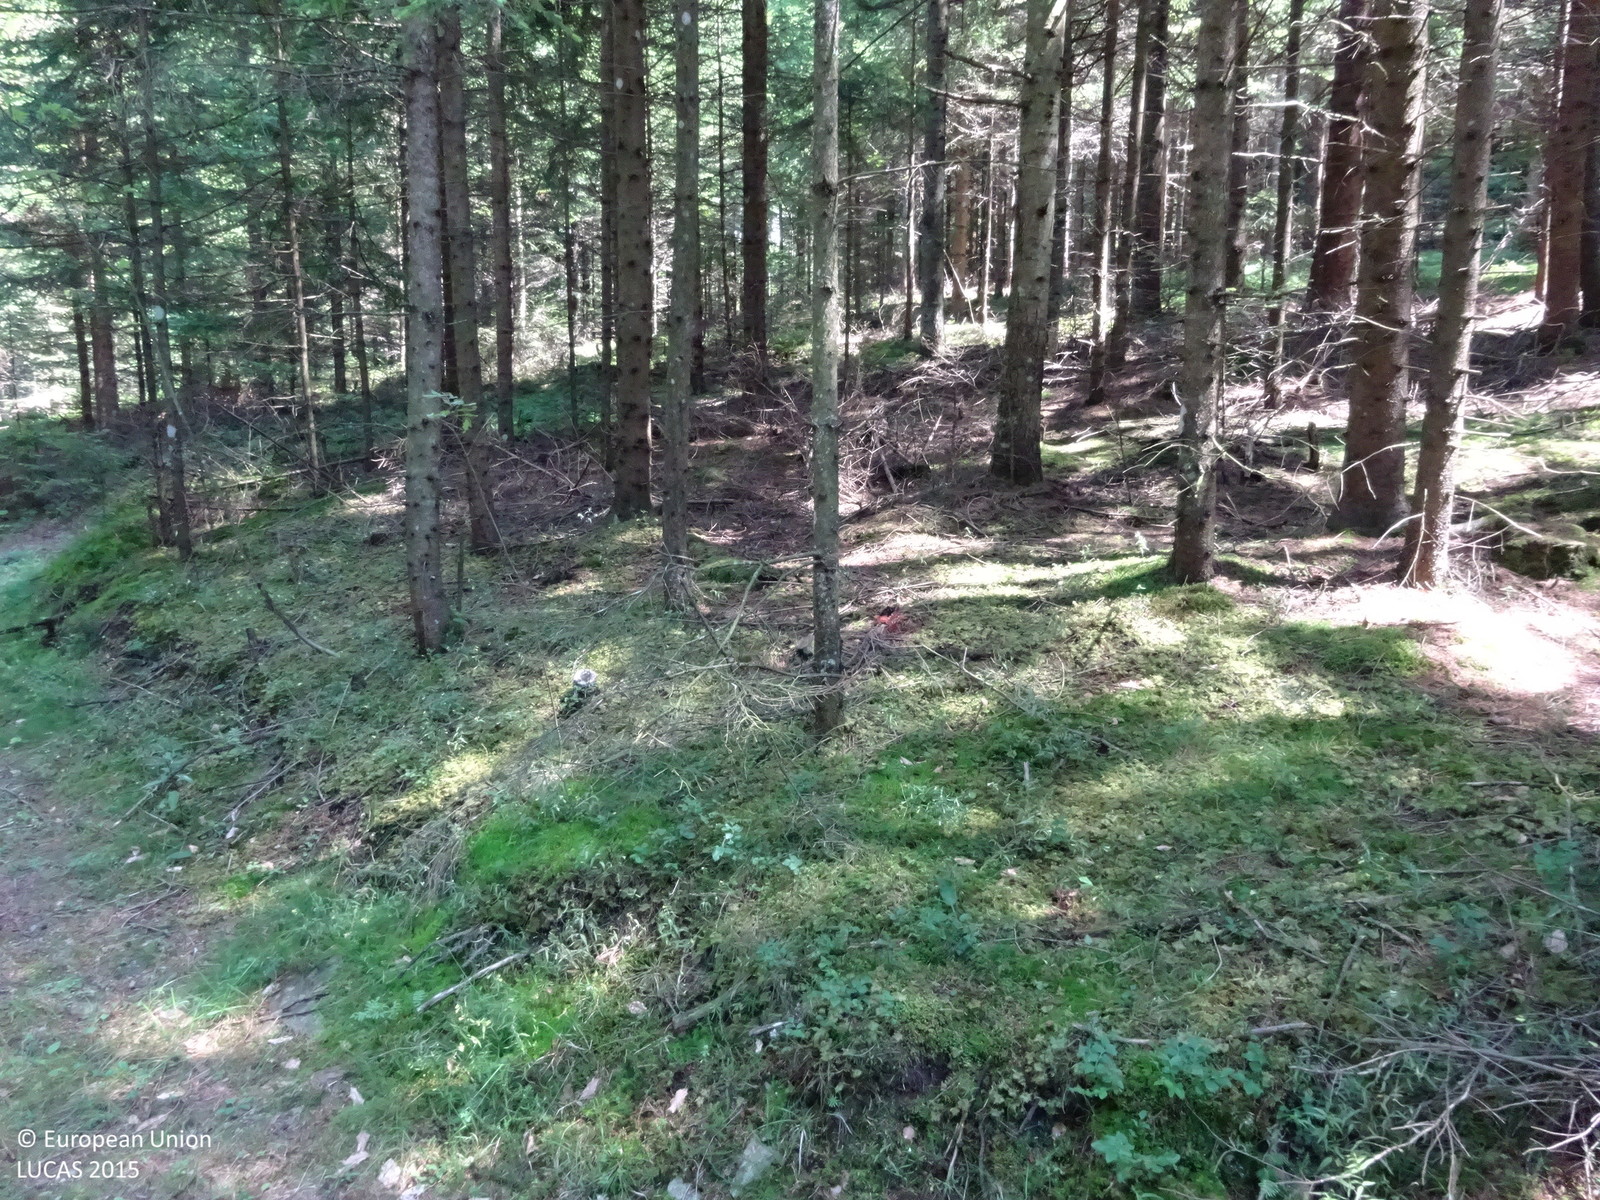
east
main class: Woodland
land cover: Spruce dominated coniferous woodland
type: alpine coniferous forest
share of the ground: > 75 %
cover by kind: coniferous forest trees 100 %
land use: Forestry
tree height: > 5 m
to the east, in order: Tracks; Spruce dominated coniferous woodland; Other coniferous woodland; Tracks; Other coniferous woodland; Tracks; Grassland without tree/shrub cover; Other coniferous woodland
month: August
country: AT
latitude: 47.3347
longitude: 15.7314
